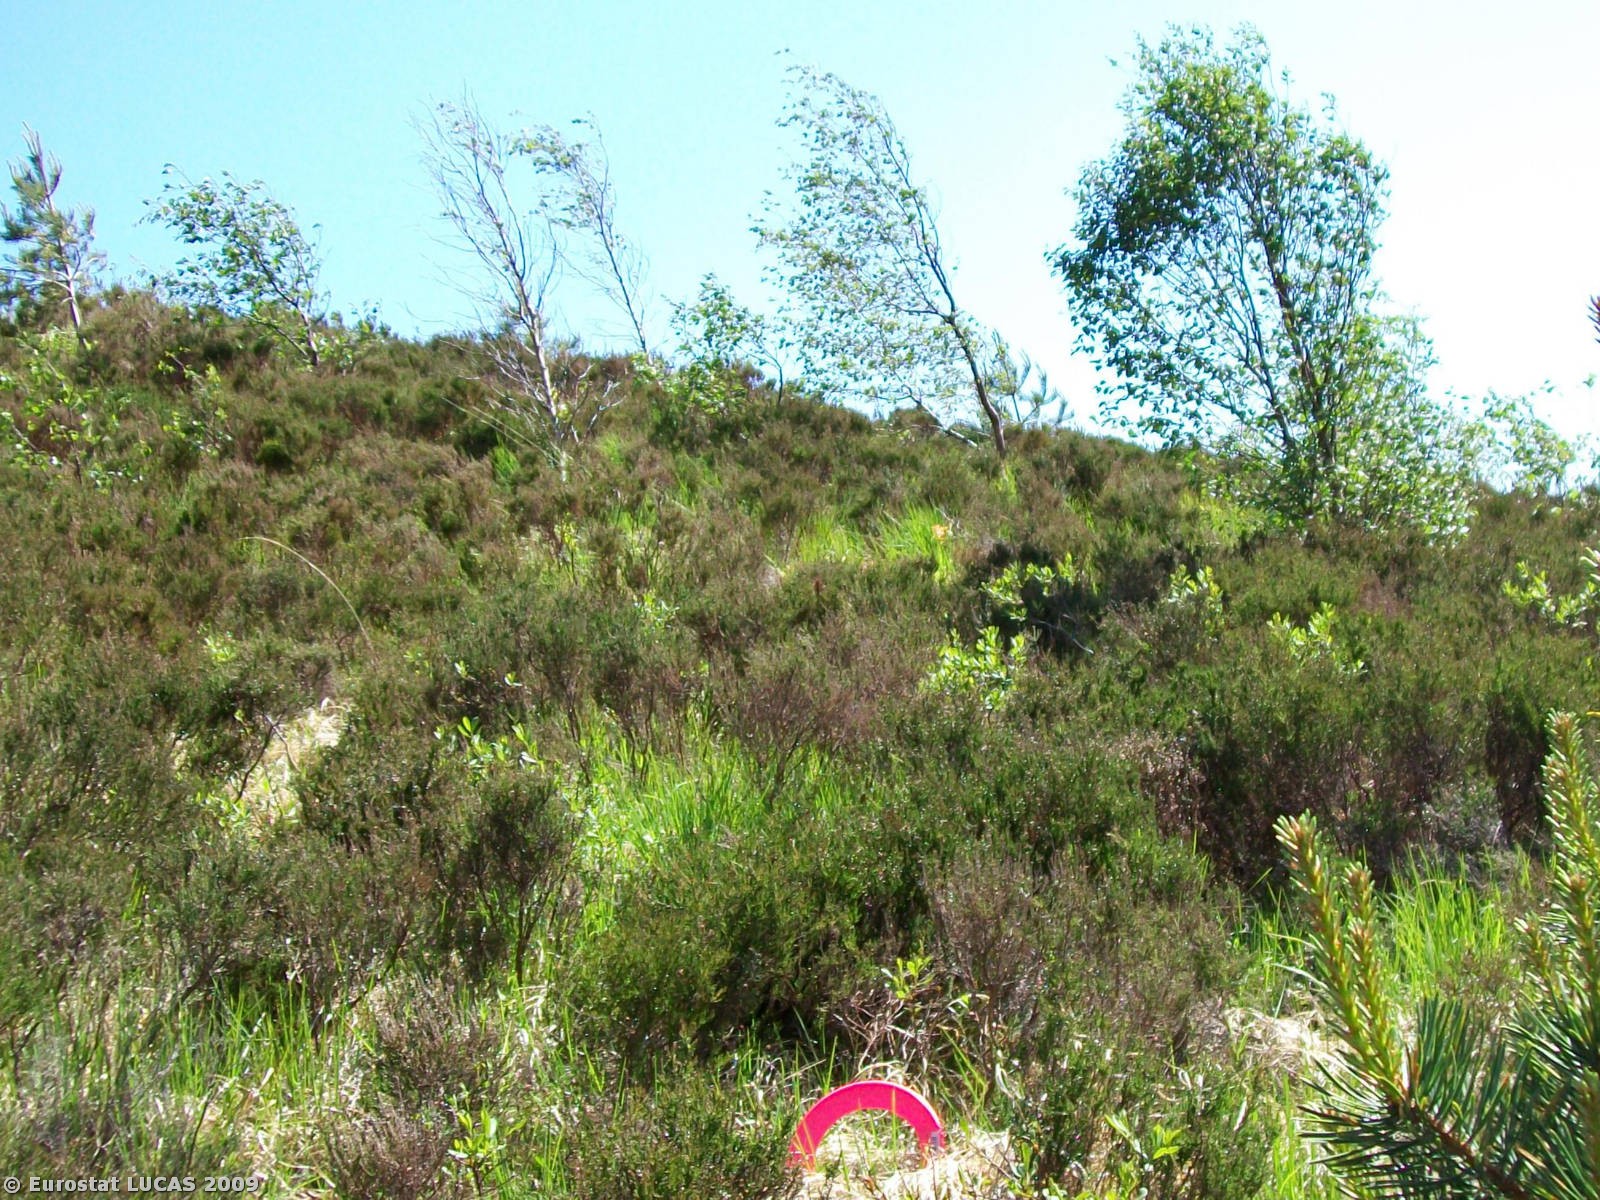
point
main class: Shrubland
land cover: Shrubland with sparse tree cover
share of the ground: > 75 %
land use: Forestry
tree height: > 5 m
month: May
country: GB
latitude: 56.6623
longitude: -5.4042
